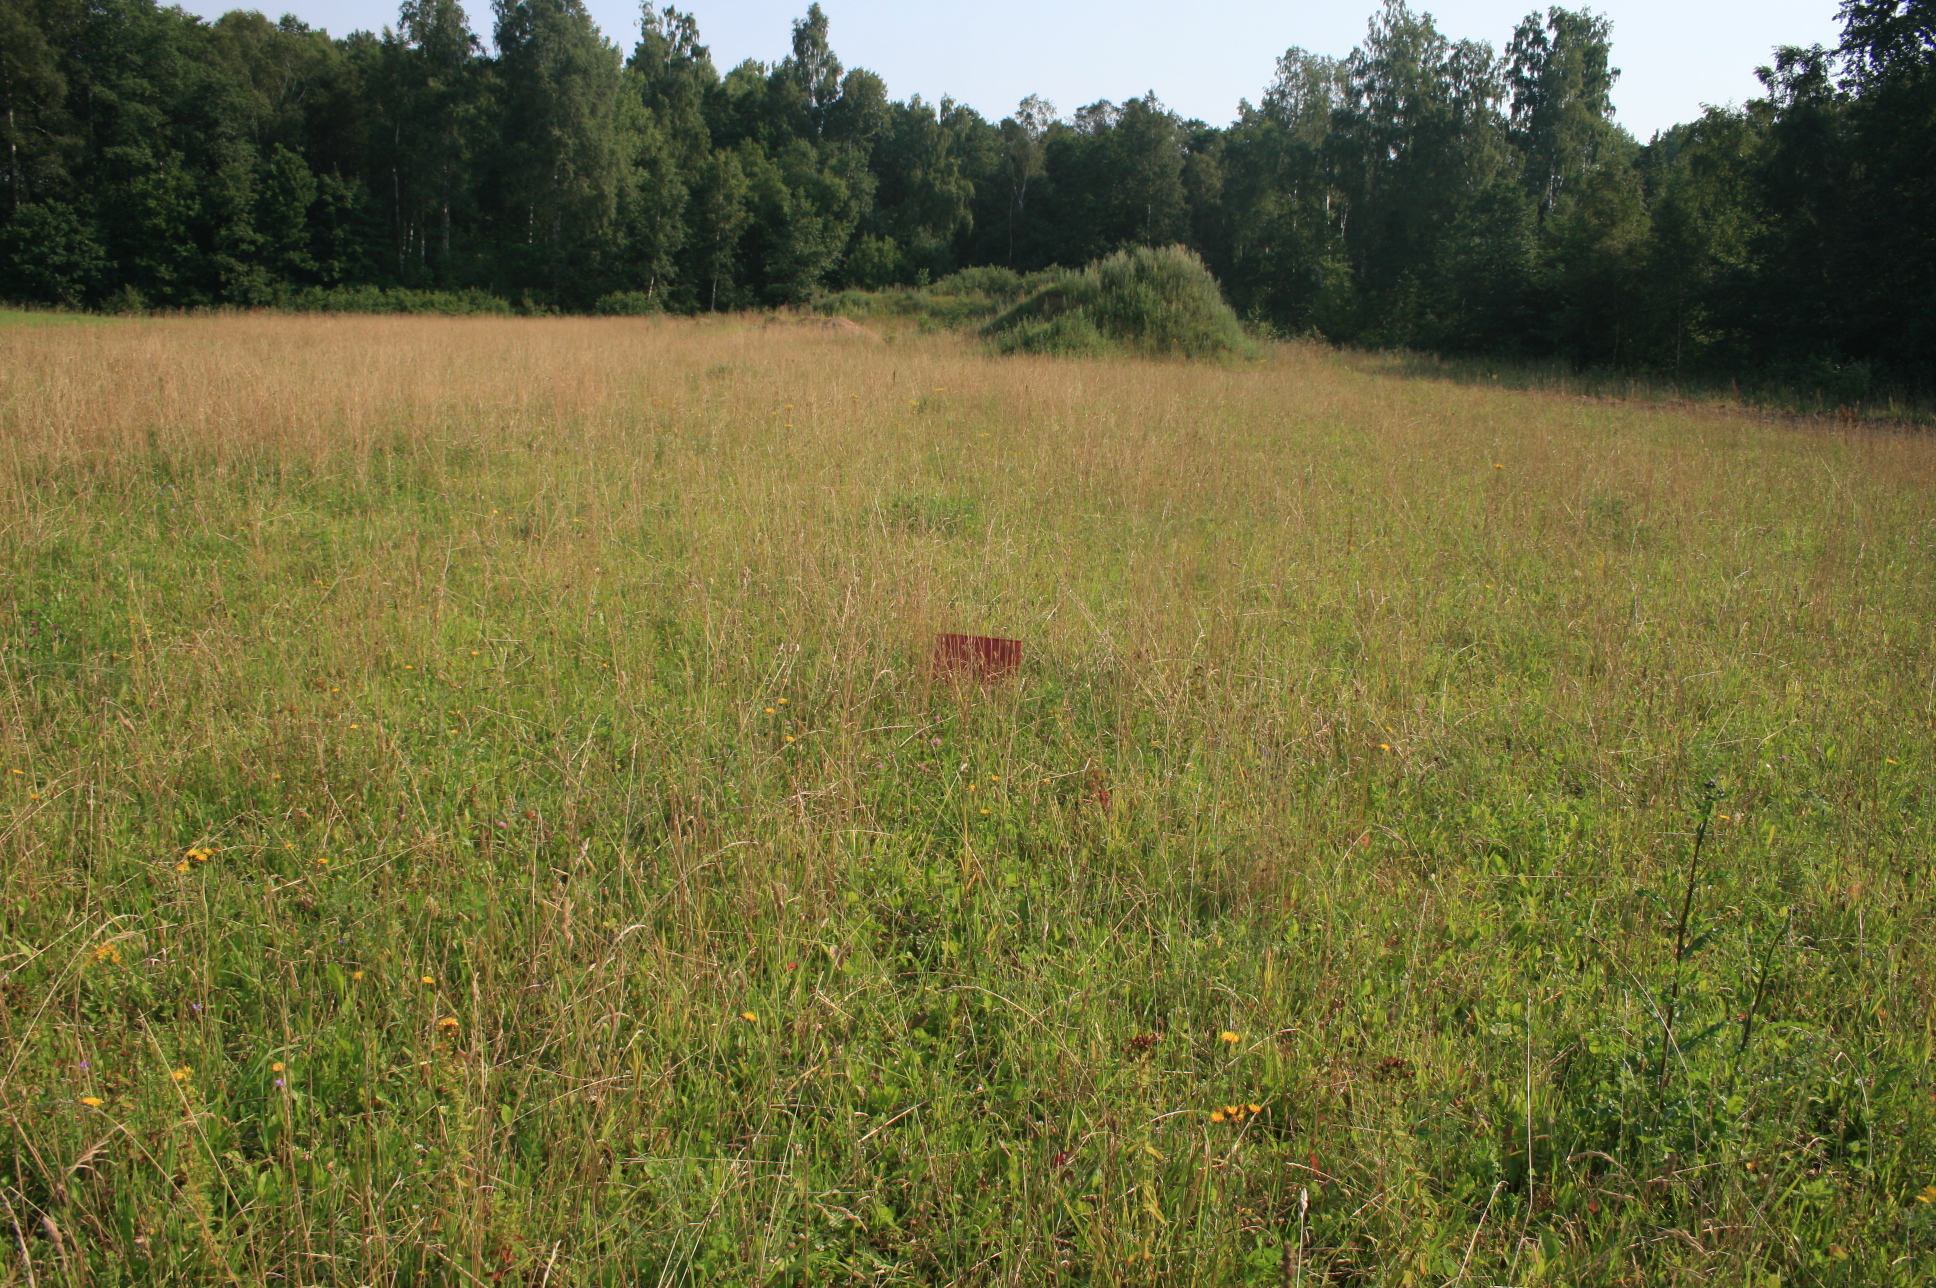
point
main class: Grassland
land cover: Grassland without tree/shrub cover
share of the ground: > 75 %
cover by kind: herbaceous plants 100 %
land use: Agriculture (excluding fallow land and kitchen gardens)
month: August
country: LT
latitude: 55.6036
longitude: 21.8114
